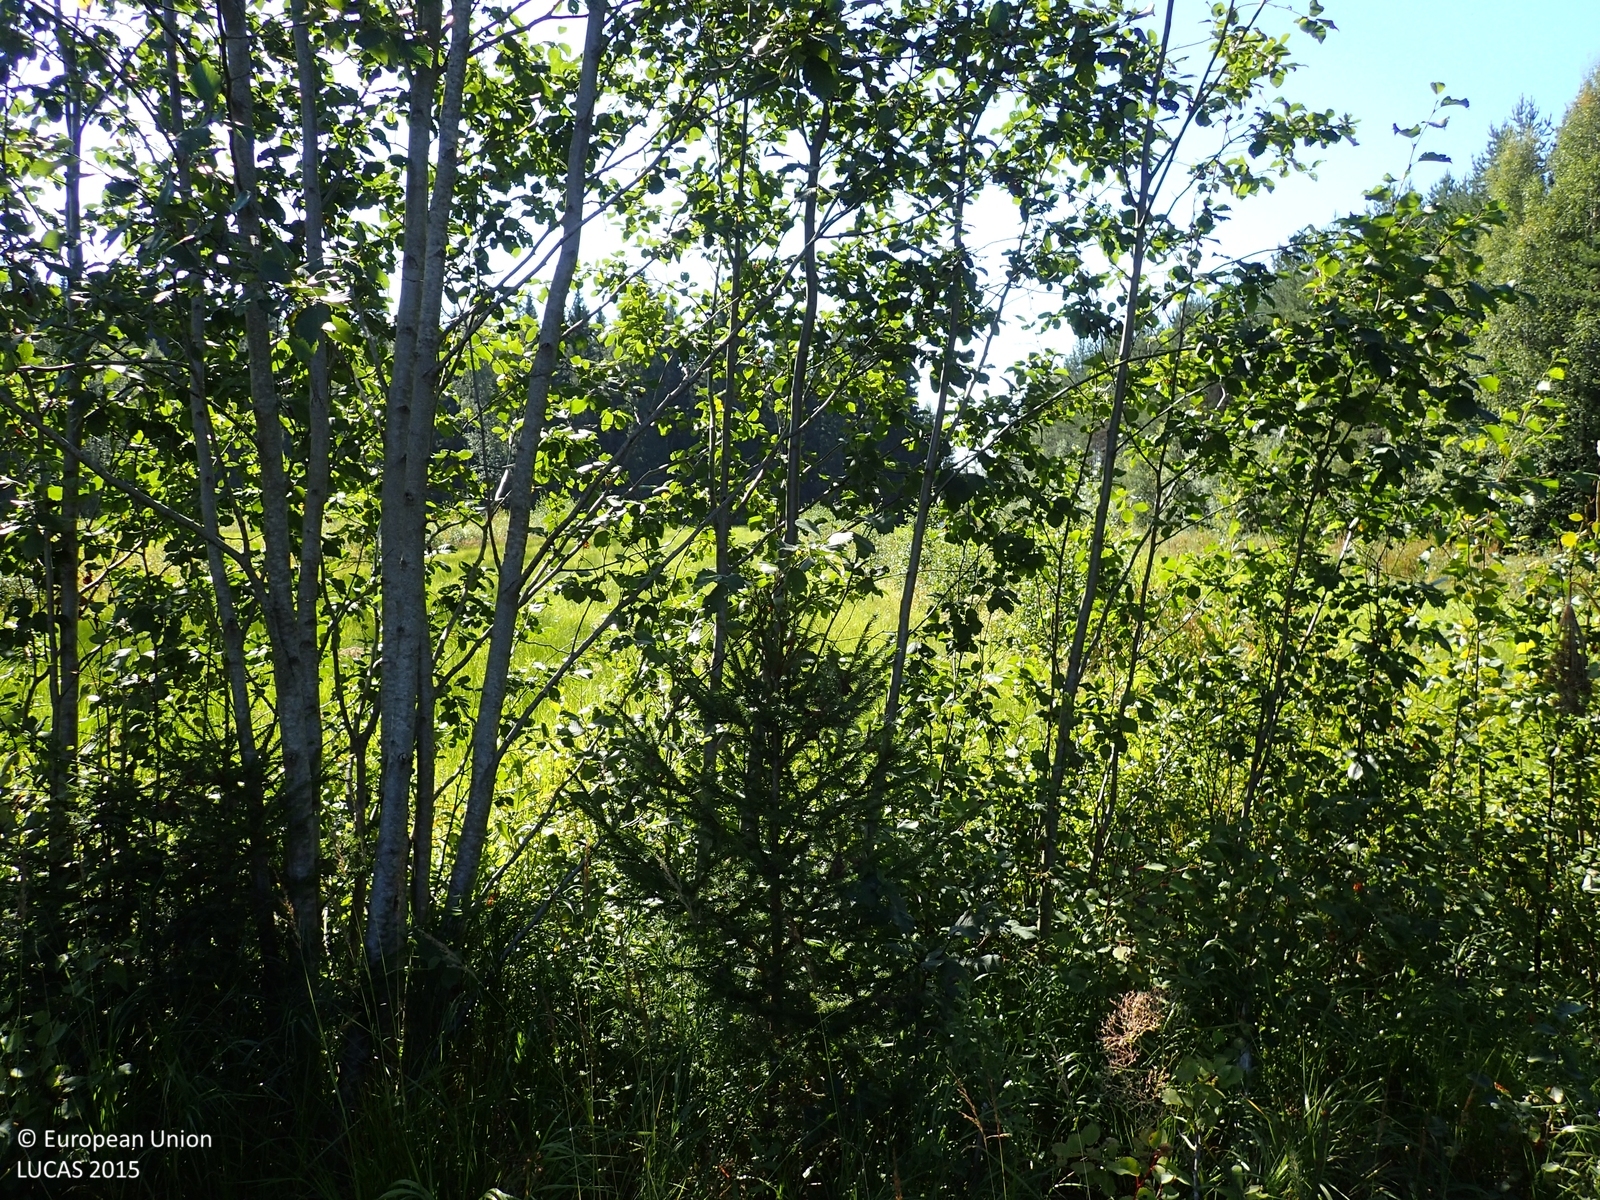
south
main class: Grassland
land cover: Grassland with sparse tree/shrub cover
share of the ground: > 75 %
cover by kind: herbaceous plants 95 %, broadleaved forest trees 5 %
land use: Forestry
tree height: < 5 m
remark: Clear cut
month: August
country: FI
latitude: 62.4267
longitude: 21.7236
